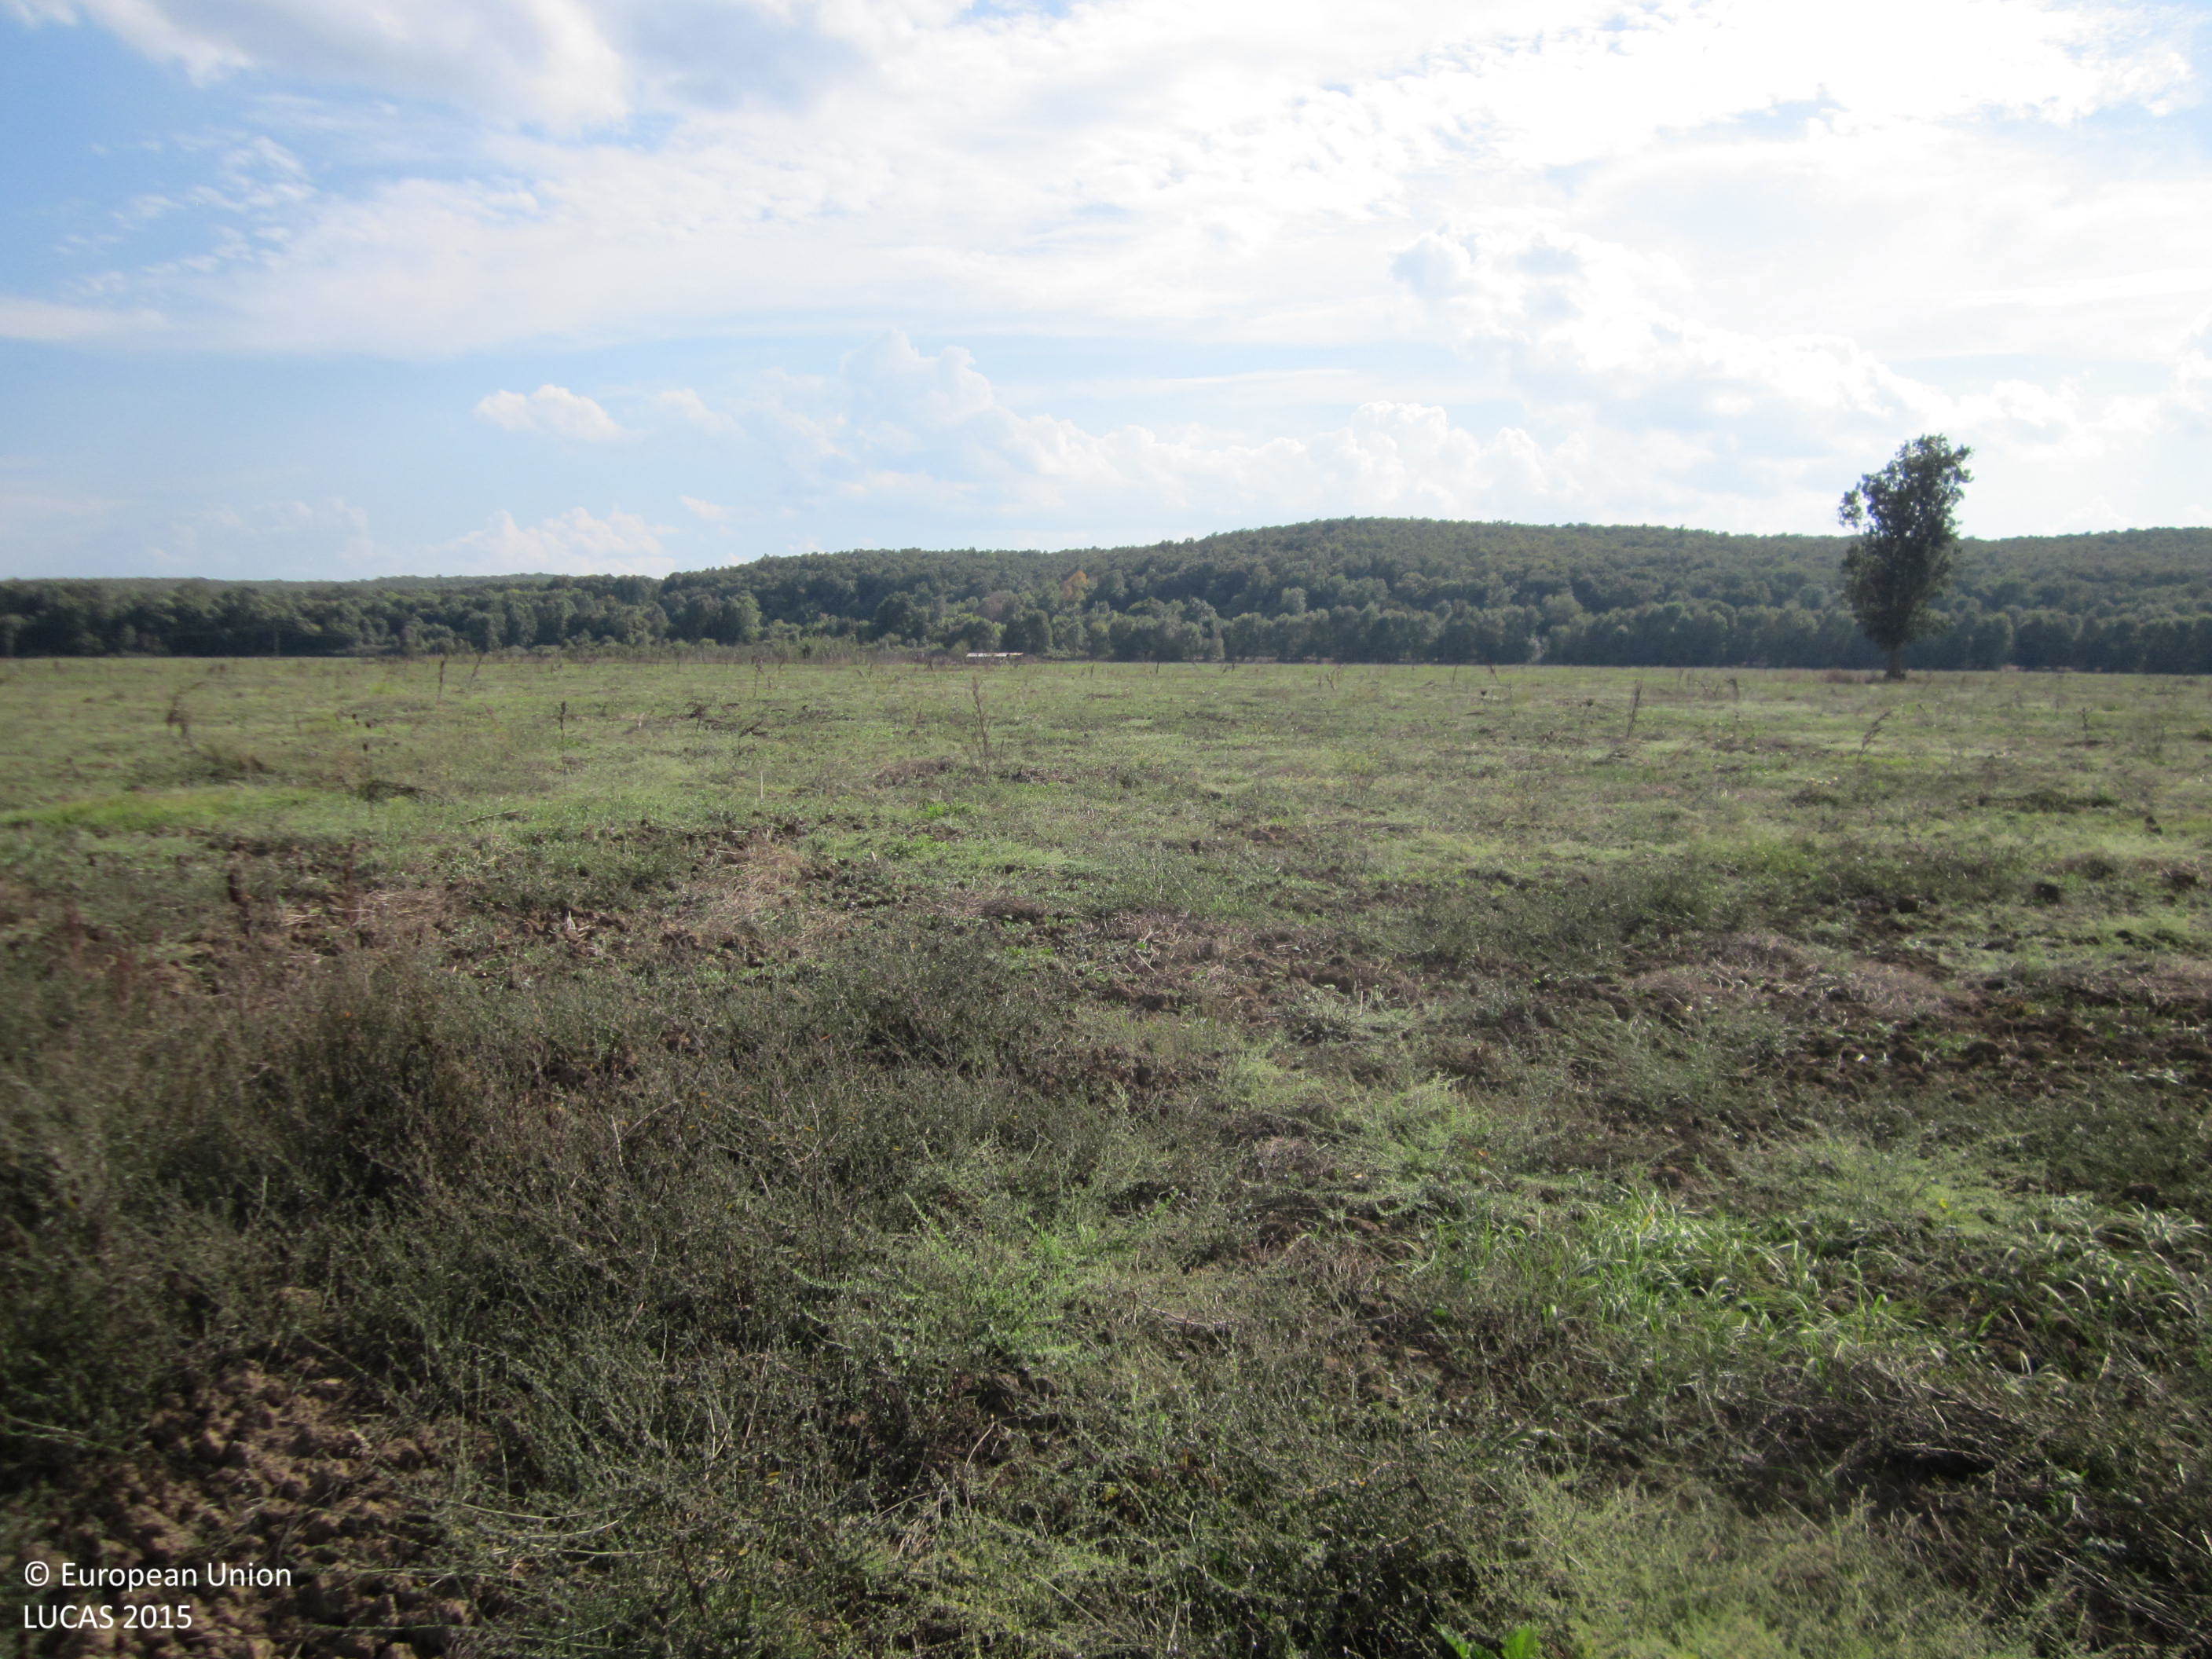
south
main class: Grassland
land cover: Grassland without tree/shrub cover
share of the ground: > 75 %
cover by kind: herbaceous plants 85 %, unconsolidated bare surface 15 %
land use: Agriculture (excluding fallow land and kitchen gardens)
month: September
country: BG
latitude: 42.2634
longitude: 27.6857
